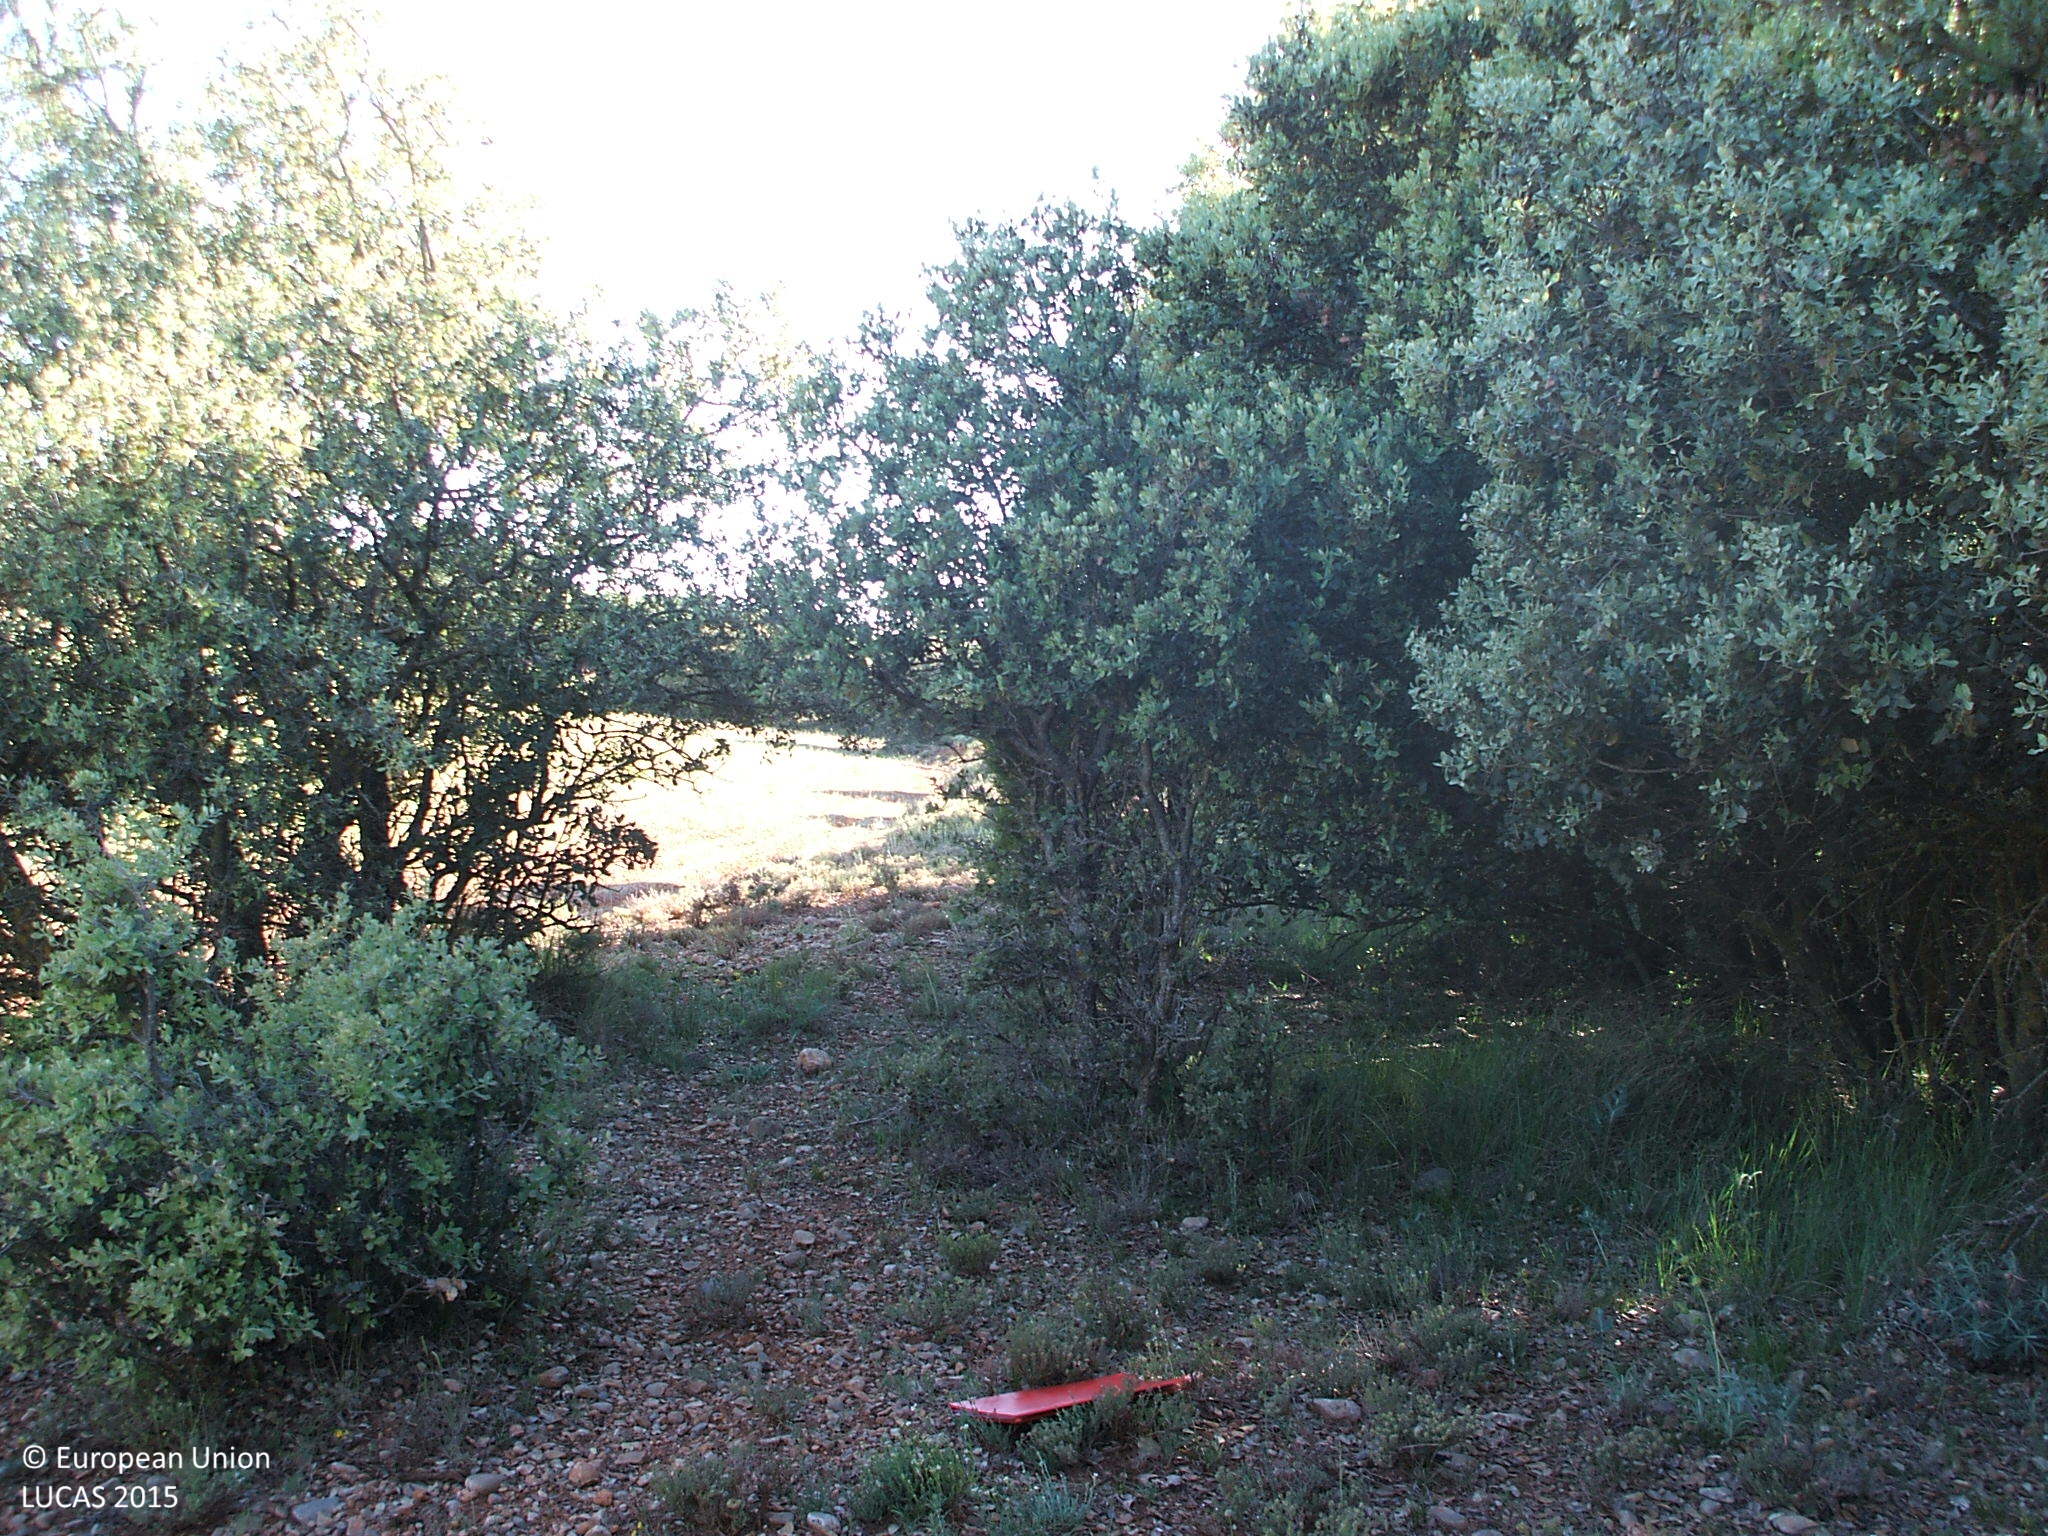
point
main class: Woodland
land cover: Broadleaved woodland
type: broadleaved evergreen forest
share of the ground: > 75 %
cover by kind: broadleaved forest trees 80 %, shrubs 20 %
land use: Semi-natural and natural areas not in use
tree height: < 5 m
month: May
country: ES
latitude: 40.0778
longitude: -0.7353
